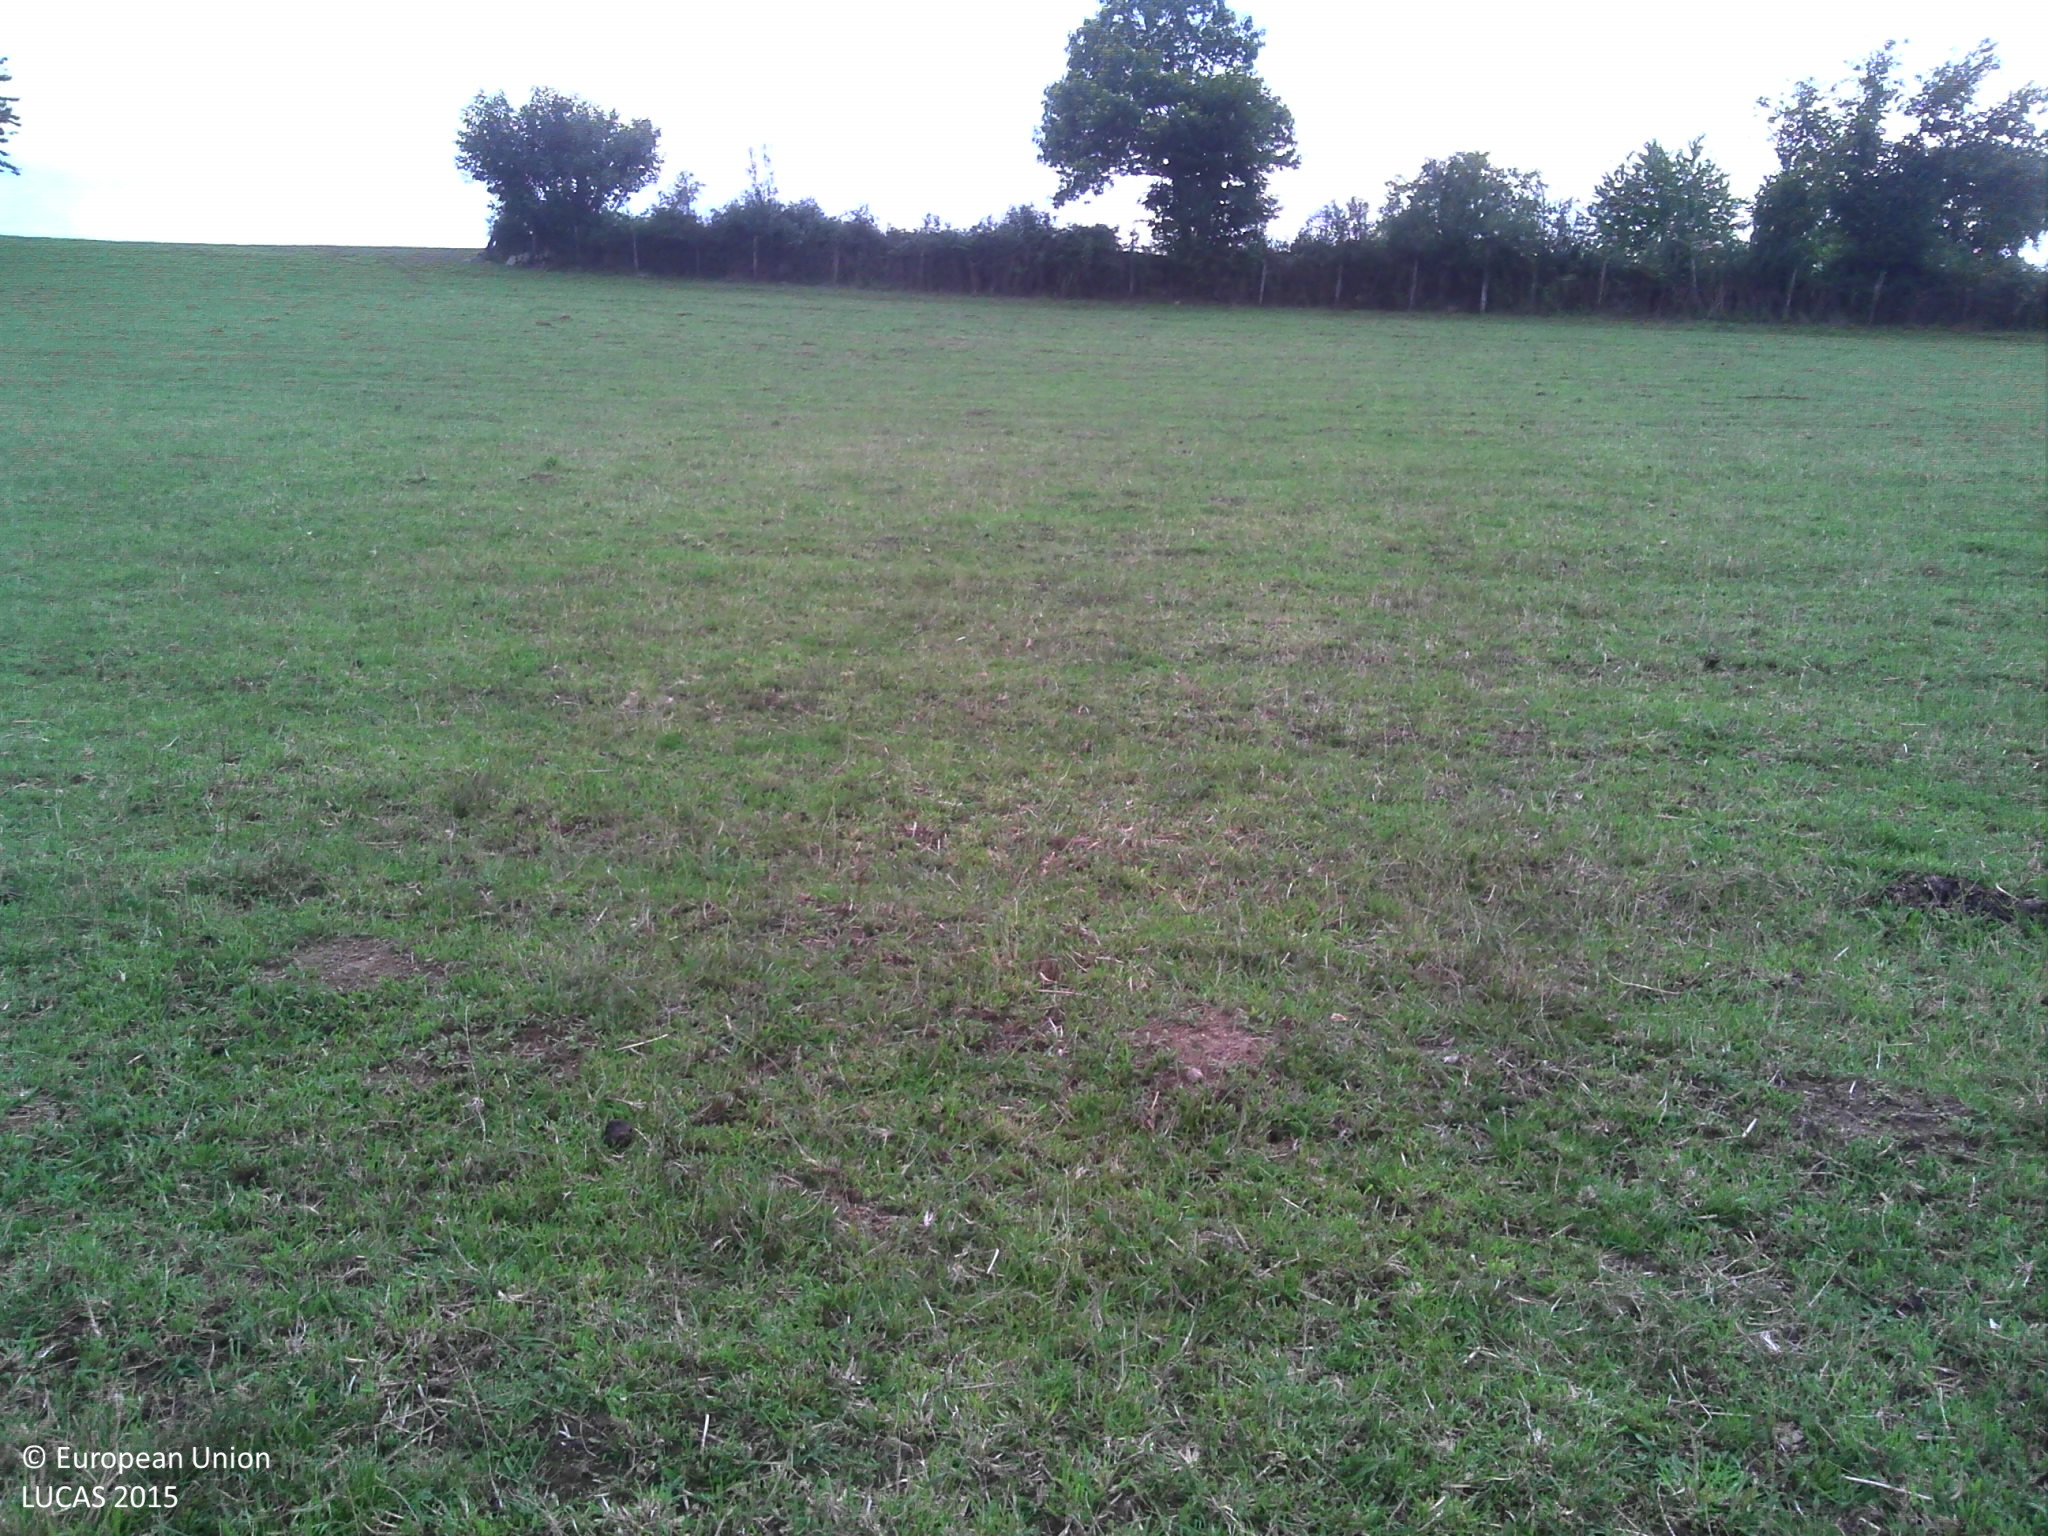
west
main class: Grassland
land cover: Grassland without tree/shrub cover
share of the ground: > 75 %
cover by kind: herbaceous plants 100 %
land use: Agriculture (excluding fallow land and kitchen gardens)
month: August
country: FR
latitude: 46.1172
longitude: 1.2292
